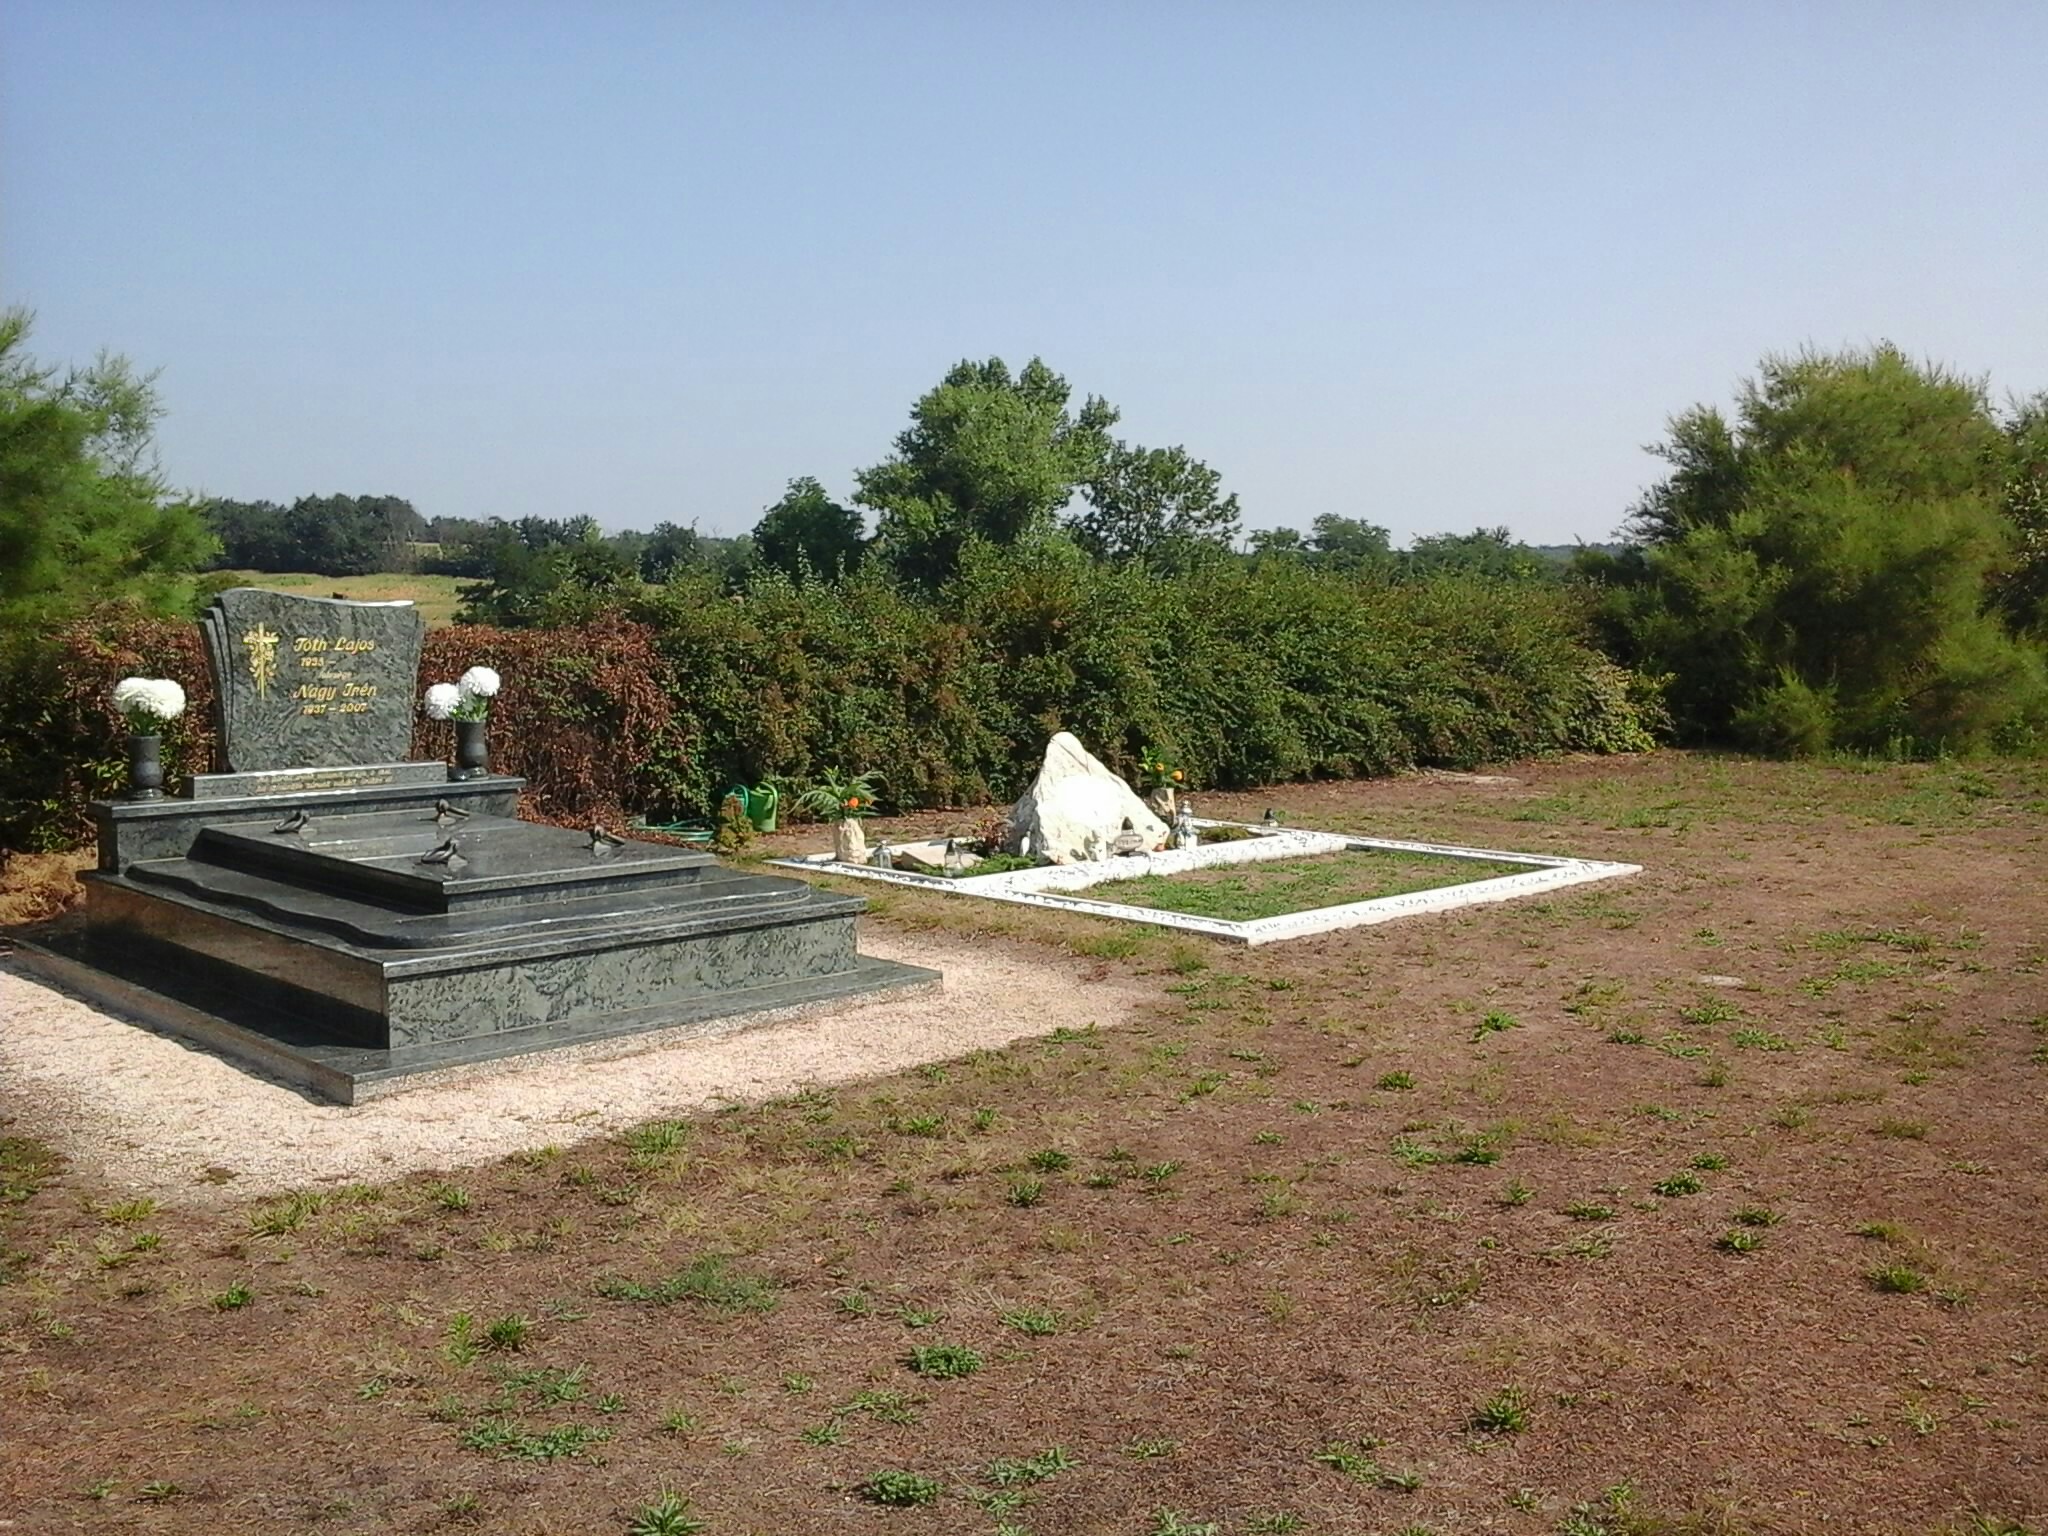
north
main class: Grassland
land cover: Grassland without tree/shrub cover
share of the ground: > 75 %
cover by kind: herbaceous plants 95 %, shrubs 5 %
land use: Community services
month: August
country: HU
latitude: 47.6462
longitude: 17.9583
